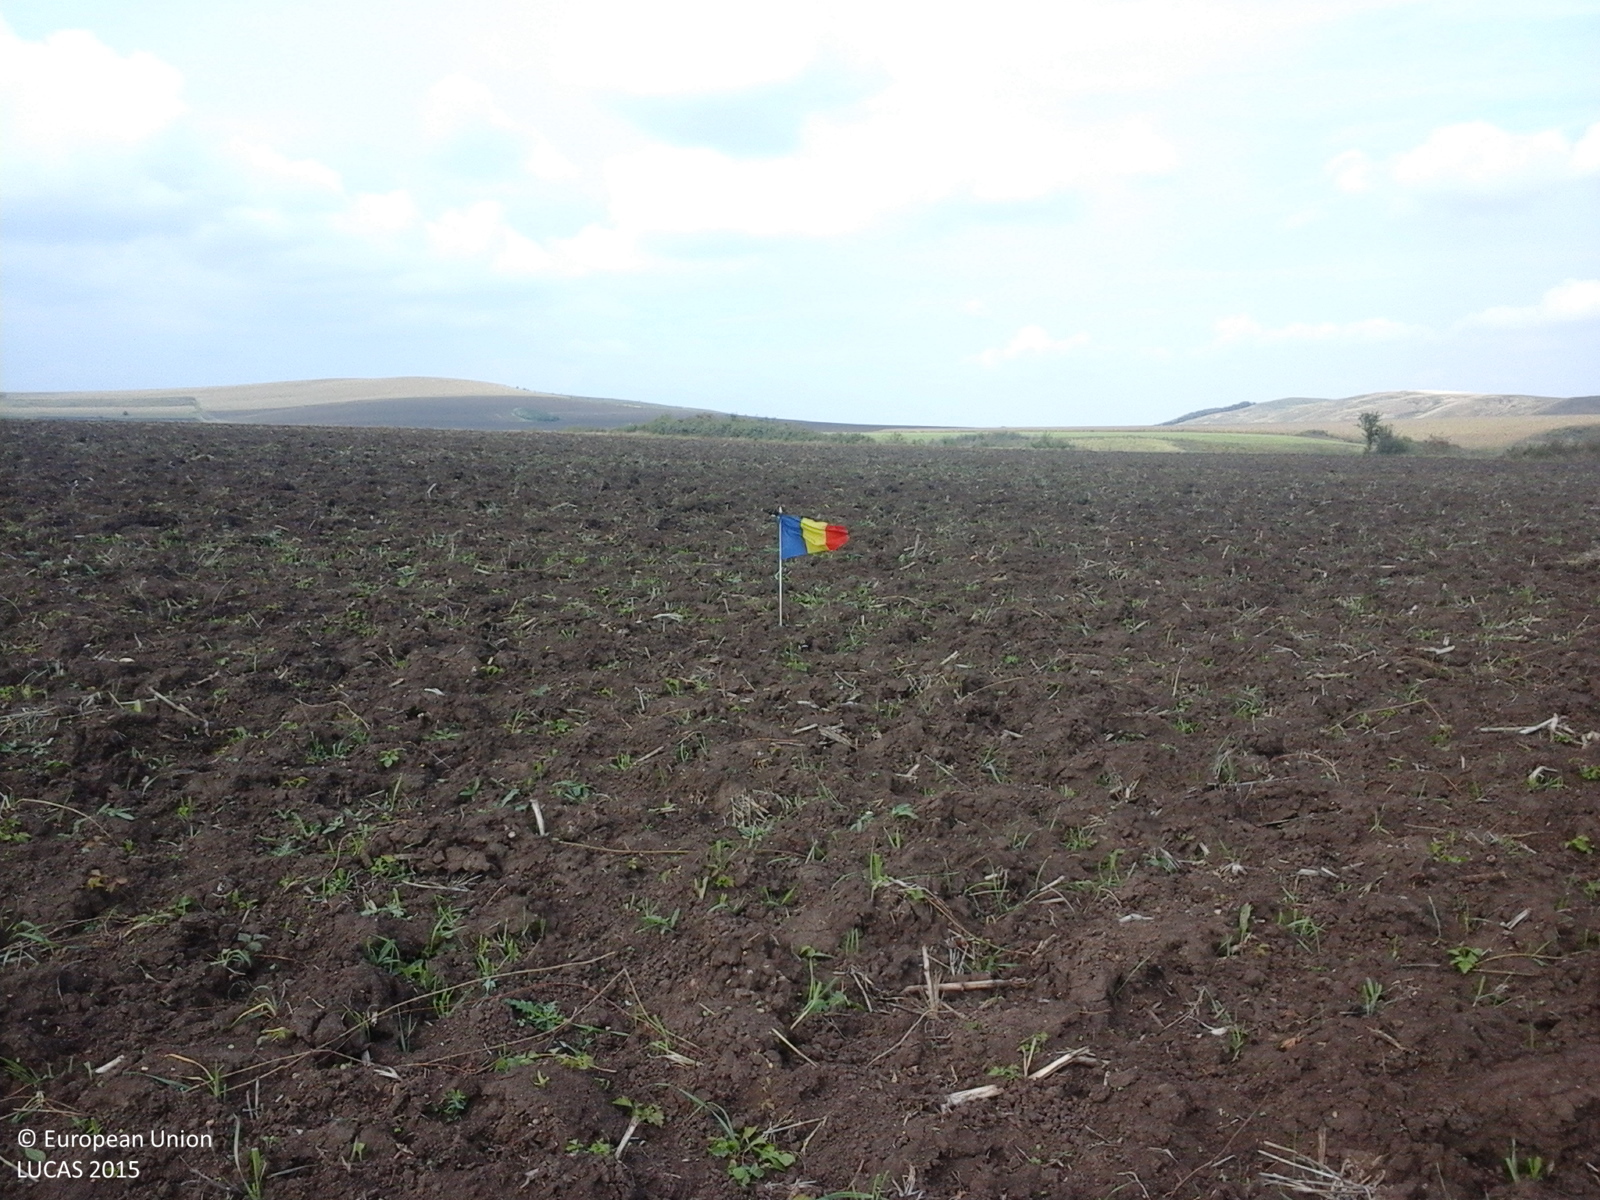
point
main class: Cropland
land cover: Maize
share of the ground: < 10 %
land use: Agriculture (excluding fallow land and kitchen gardens)
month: October
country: RO
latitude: 46.4447
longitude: 23.8855
